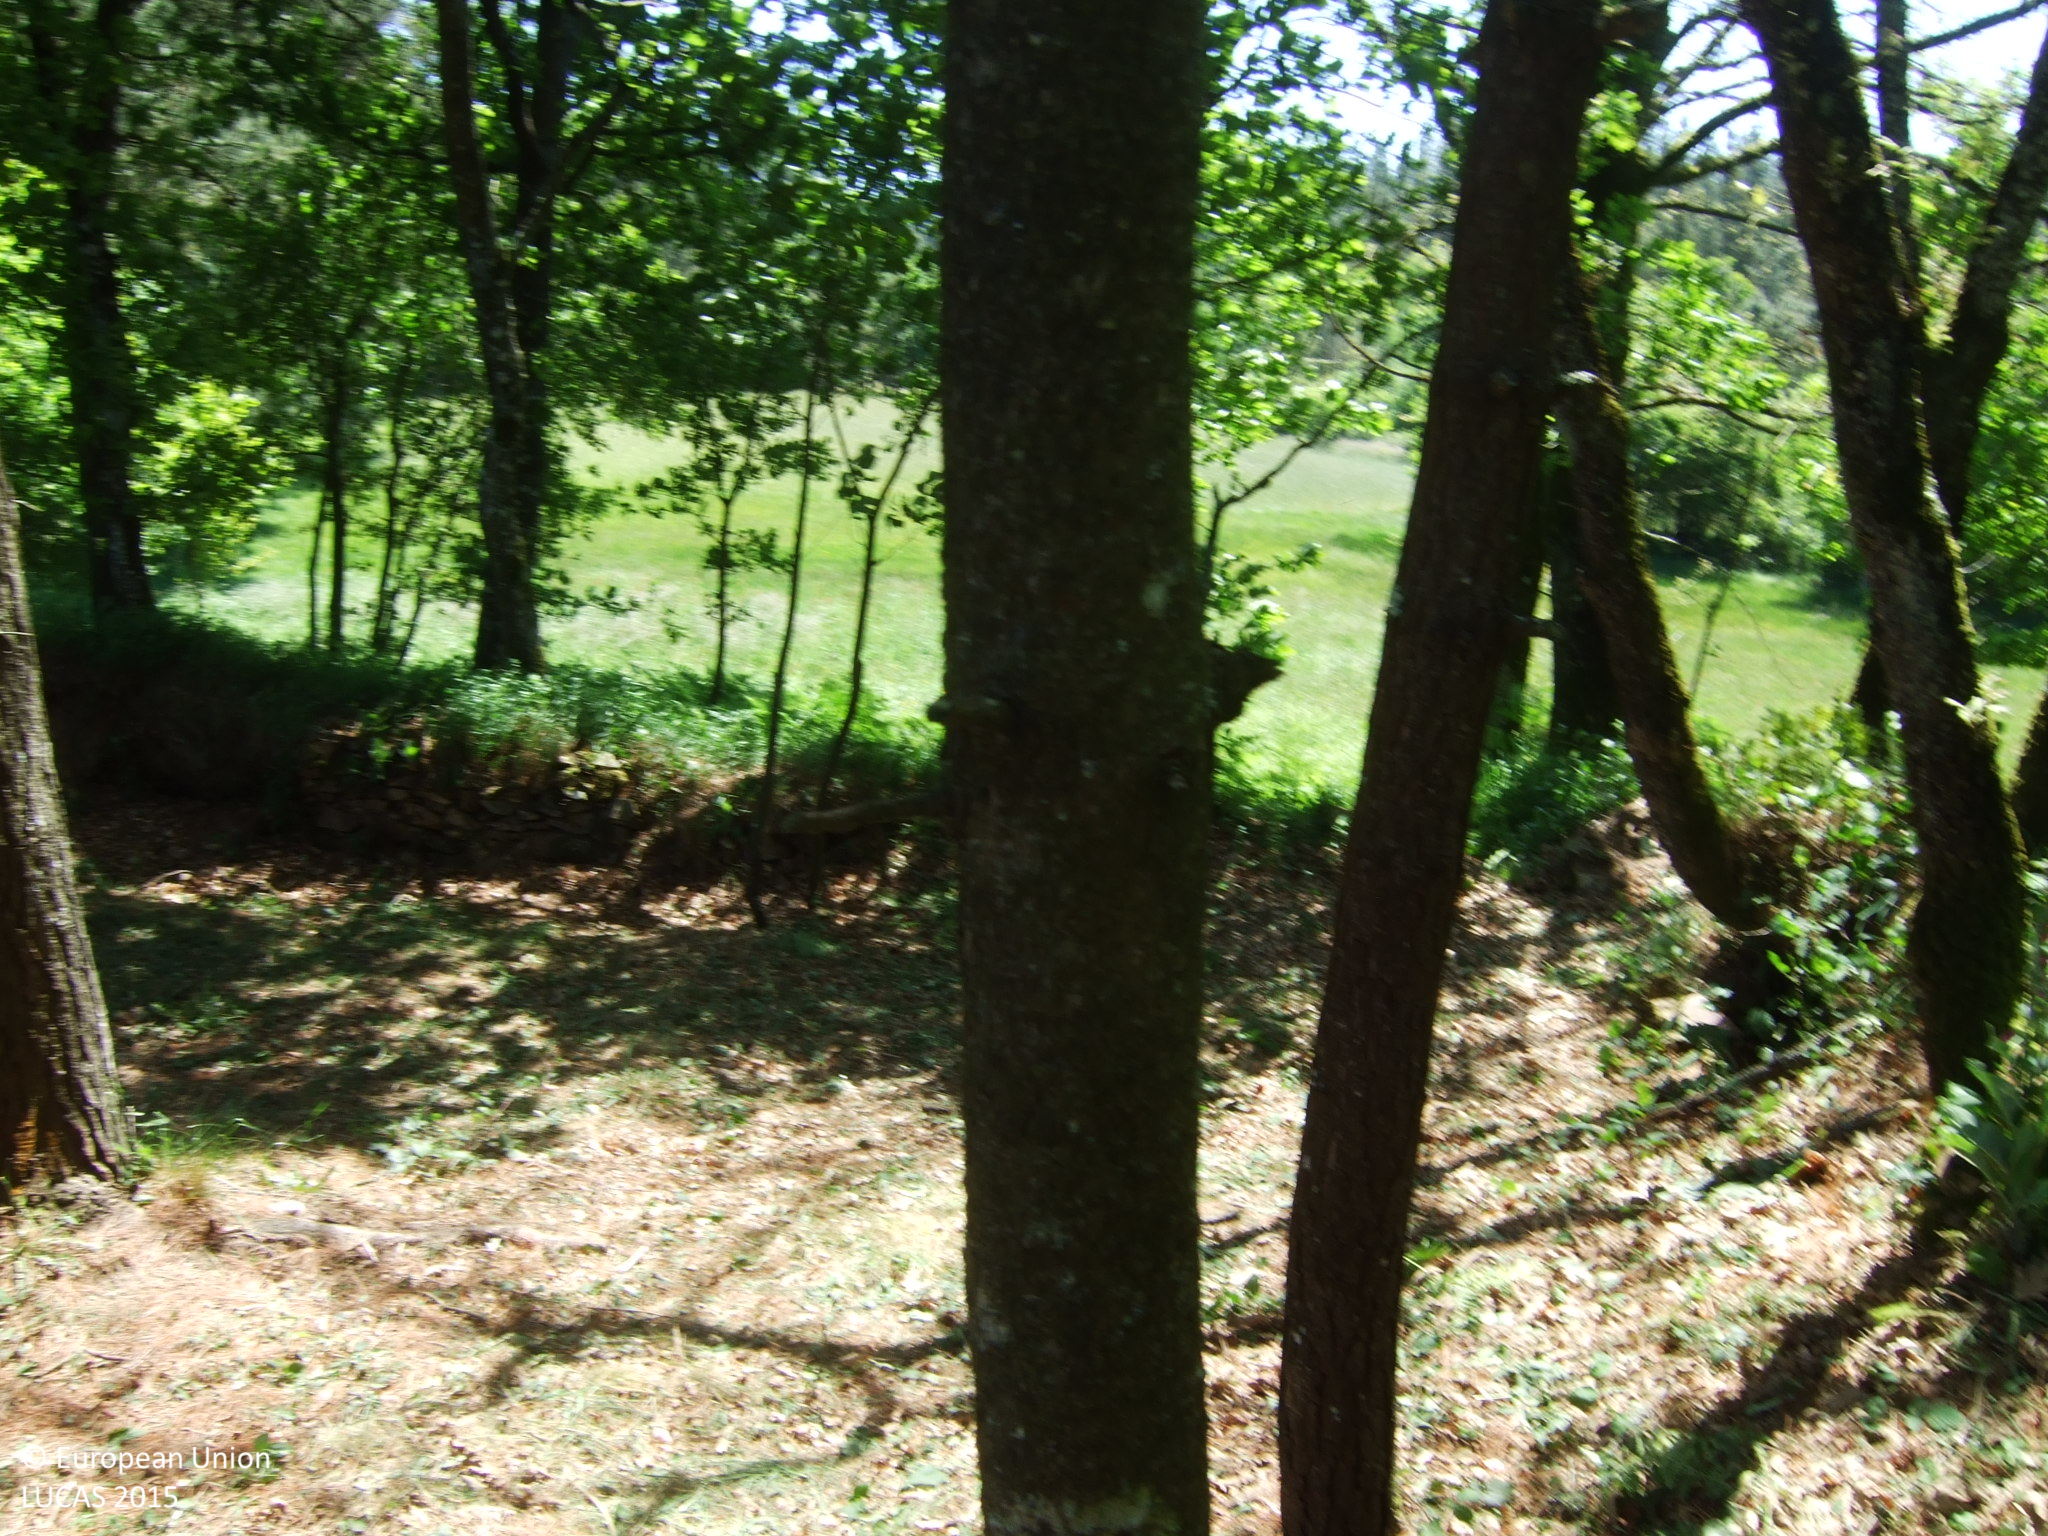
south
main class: Woodland
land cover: Pine dominated coniferous woodland
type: exotic forest
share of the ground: 50 - 75 %
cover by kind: coniferous forest trees 55 %, unconsolidated bare surface 35 %, shrubs 10 %
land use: Forestry
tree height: > 5 m
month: May
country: ES
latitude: 43.2279
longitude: -7.6523
